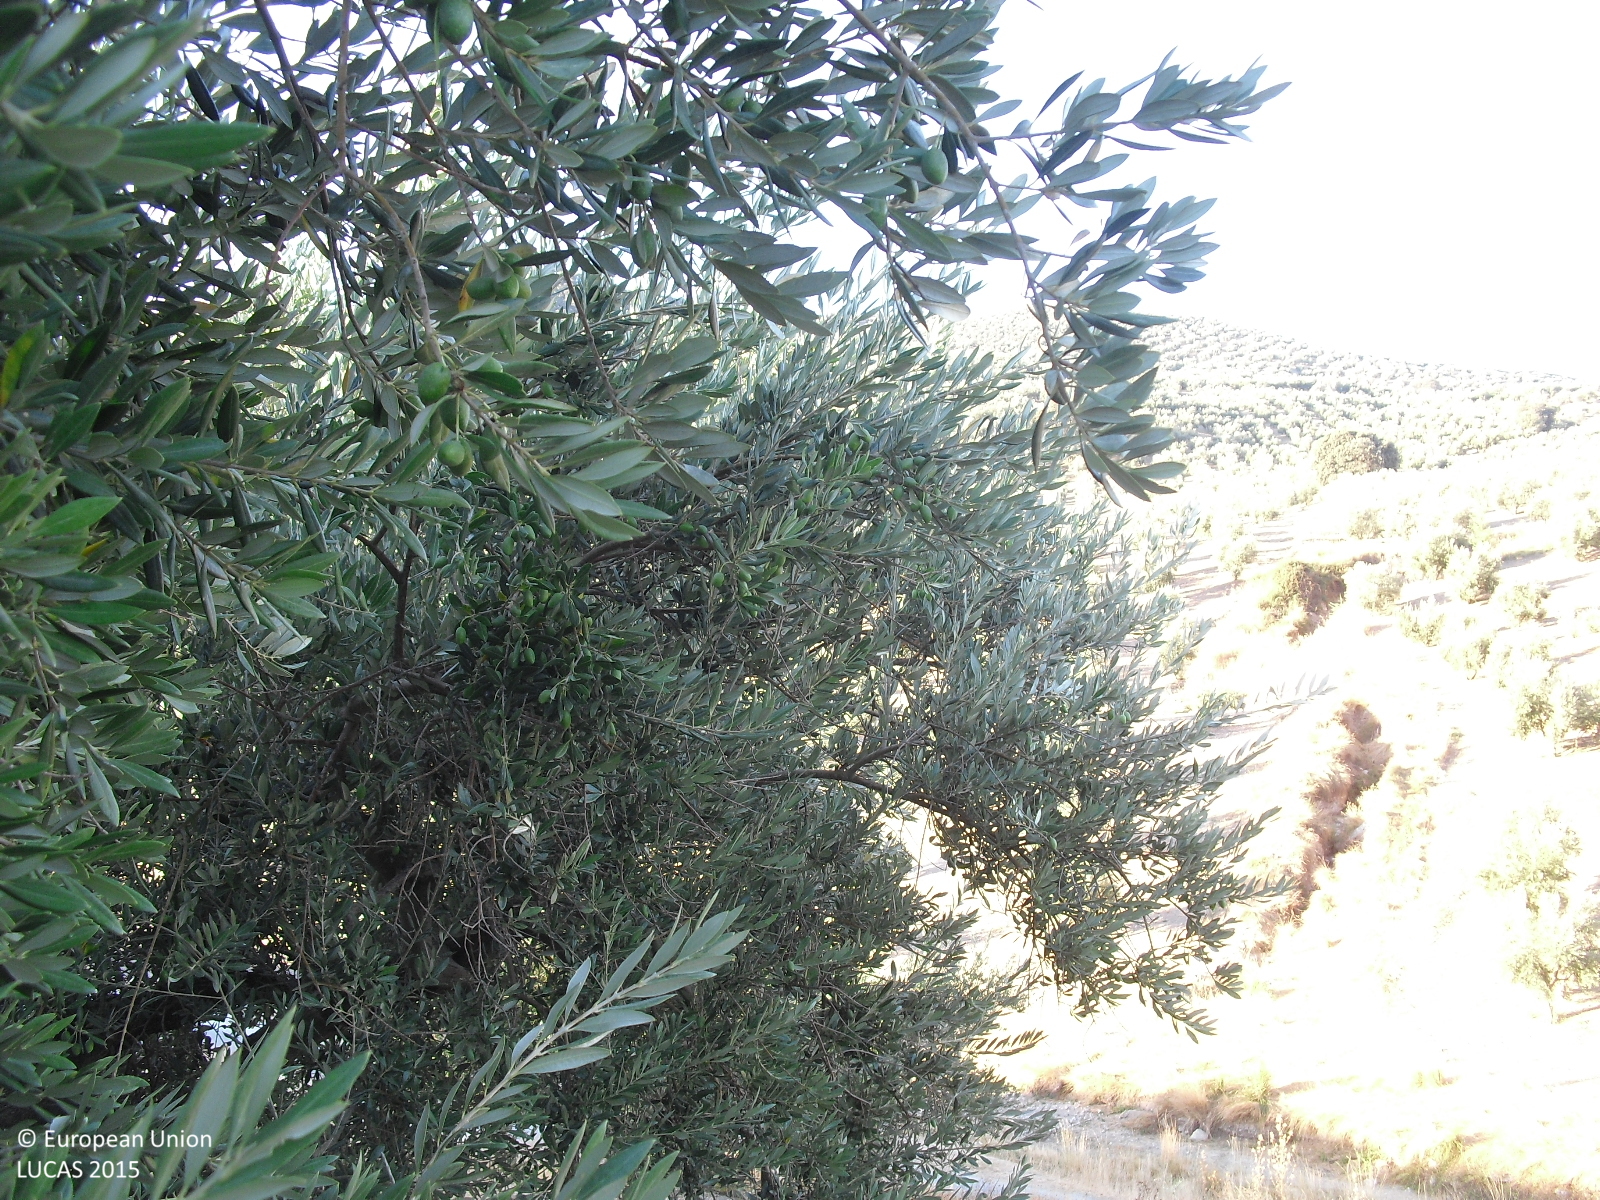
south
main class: Cropland
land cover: Olive groves
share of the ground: 10 - 25 %
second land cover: Spontaneously vegetated surfaces
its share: 25 - 50 %
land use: Agriculture (excluding fallow land and kitchen gardens)
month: August
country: ES
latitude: 37.2607
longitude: -4.1015
